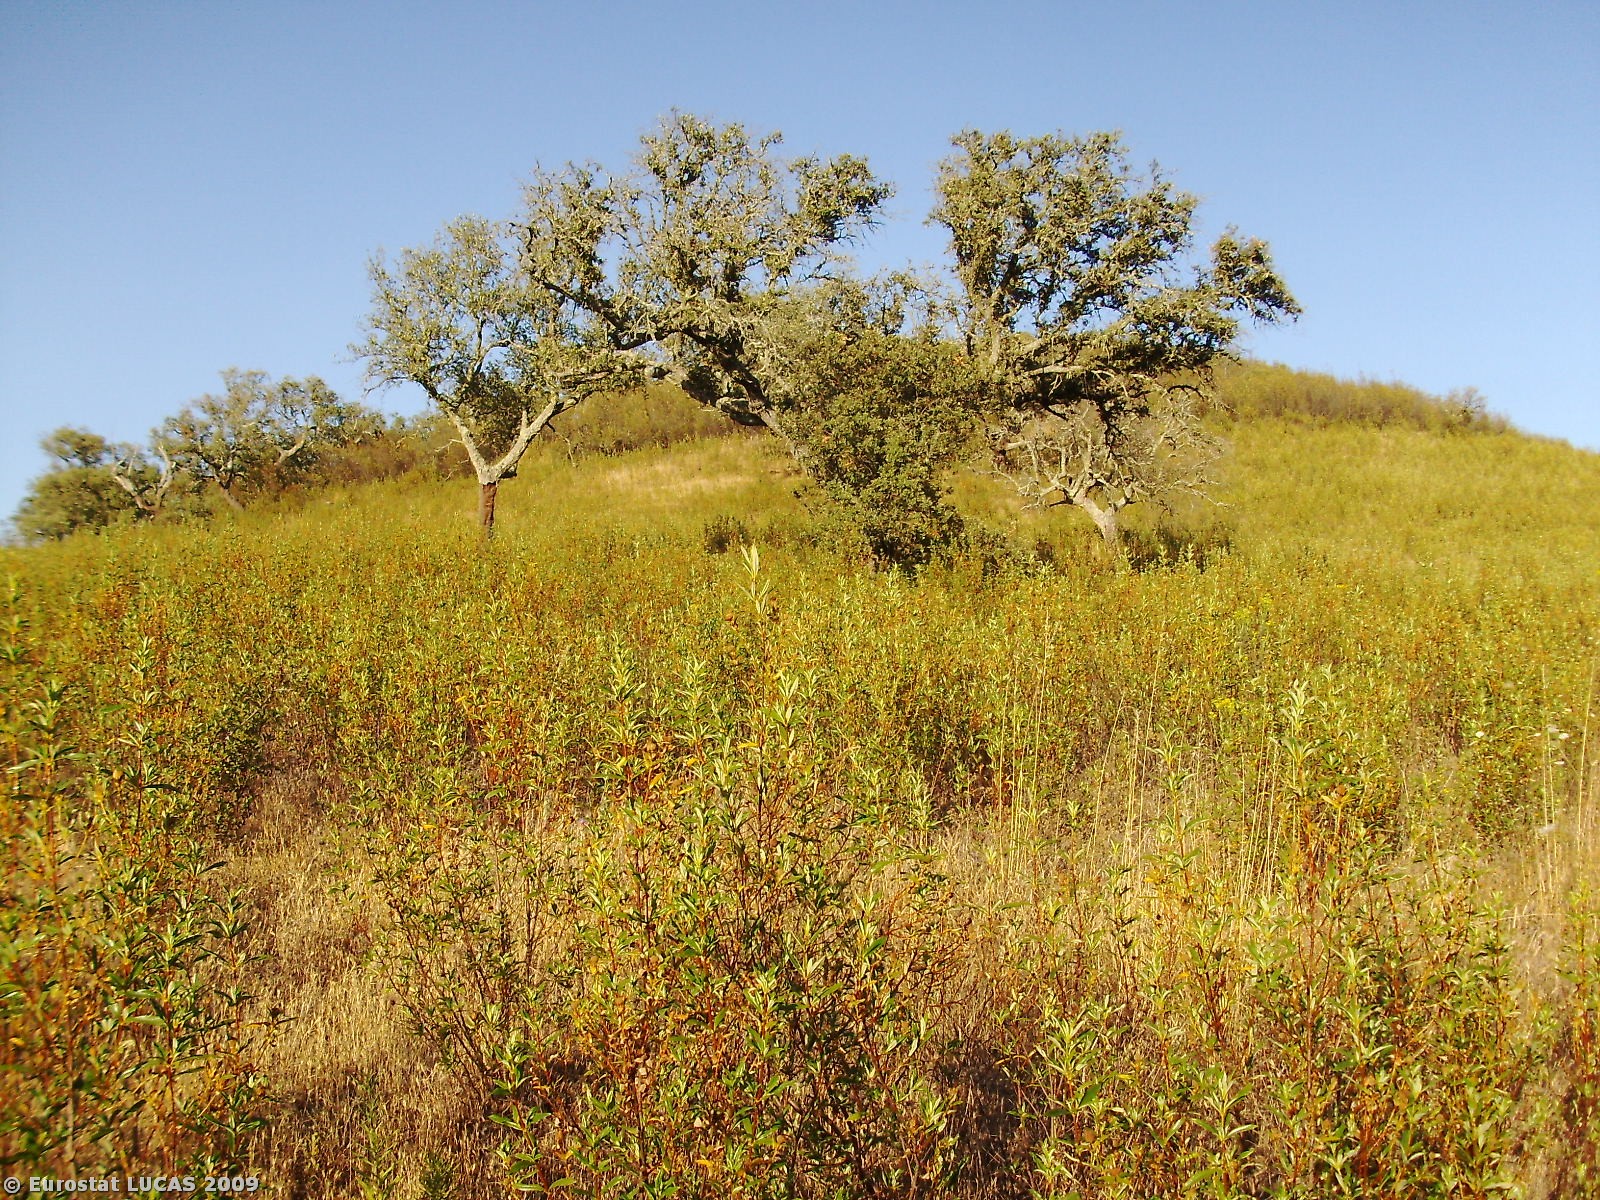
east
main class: Shrubland
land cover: Shrubland with sparse tree cover
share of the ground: 50 - 75 %
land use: Fallow land
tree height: > 5 m
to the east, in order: Shrubland with sparse tree cover; Broadleaved woodland; Shrubland with sparse tree cover
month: June
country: PT
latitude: 37.7448
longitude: -8.4322
